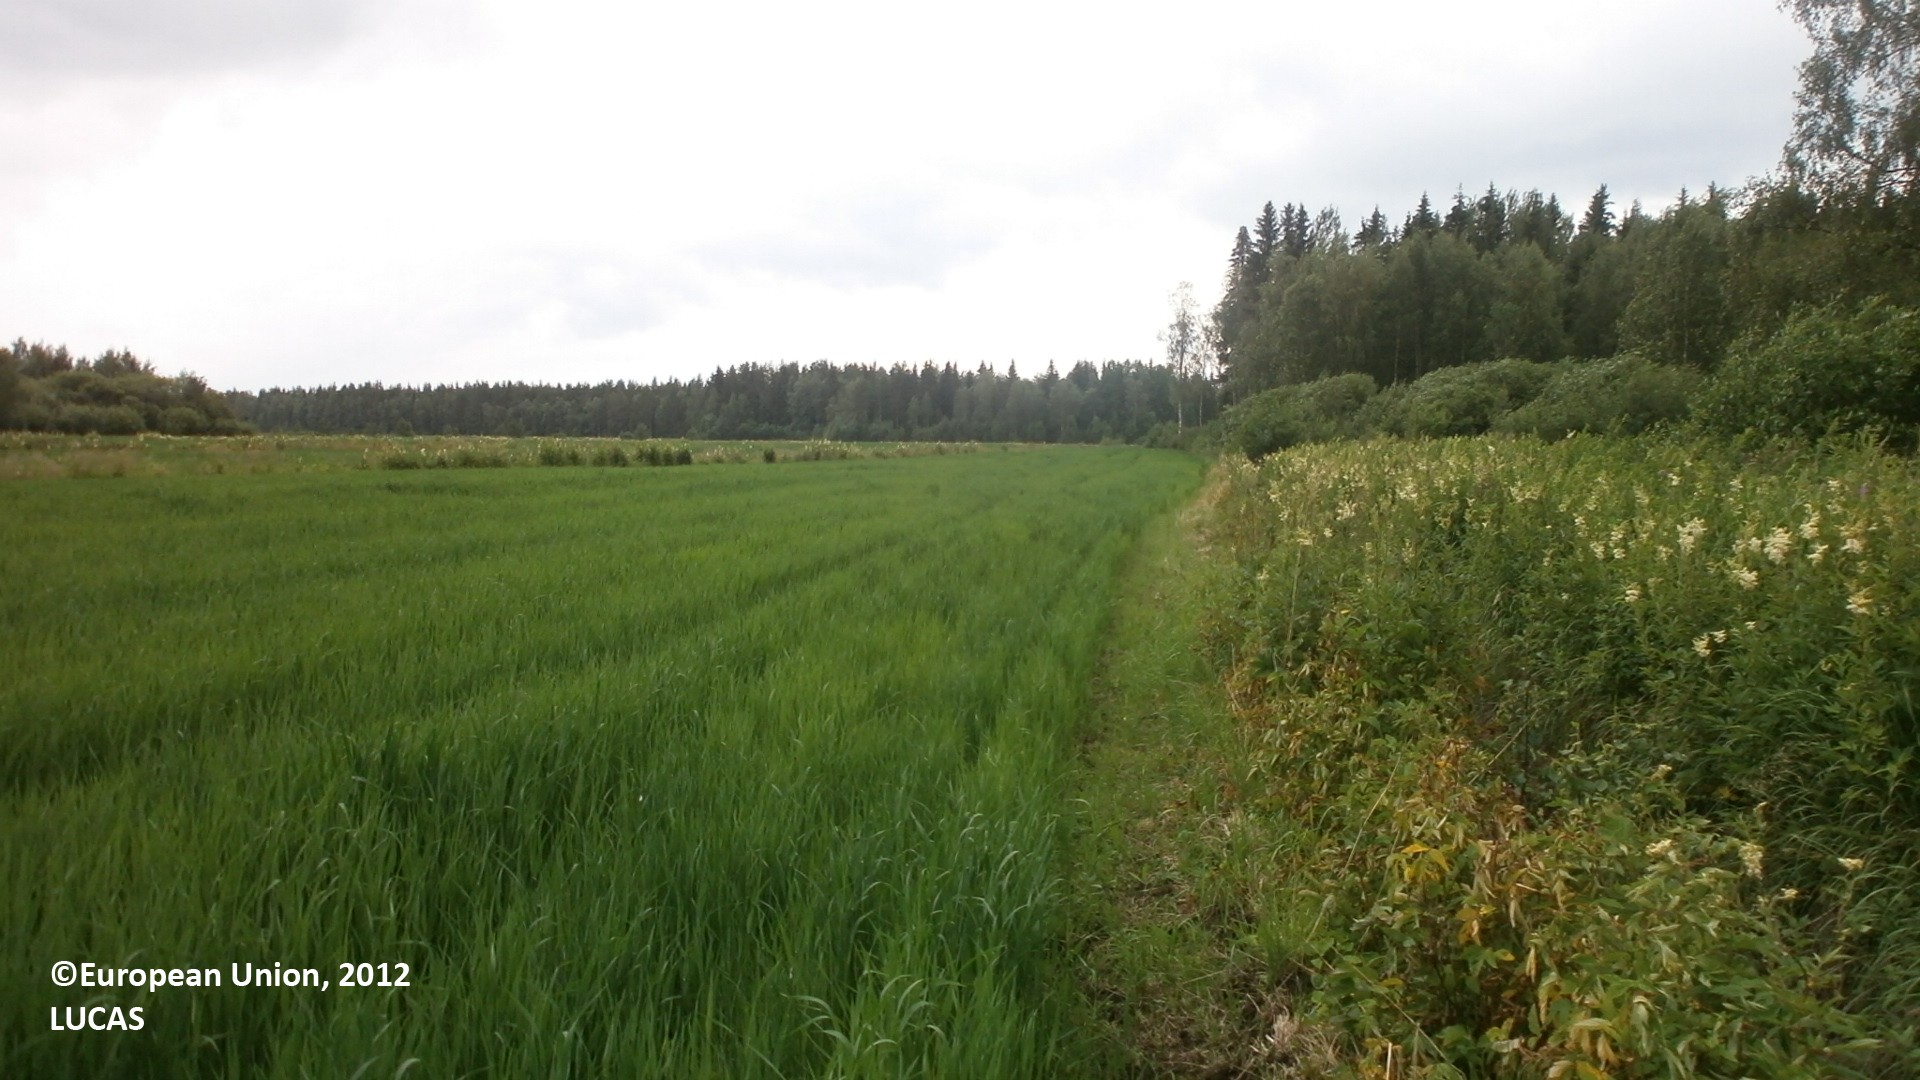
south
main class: Cropland
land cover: Oats
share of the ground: > 75 %
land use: Agriculture (excluding fallow land and kitchen gardens)
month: July
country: FI
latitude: 64.6212
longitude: 24.6029
